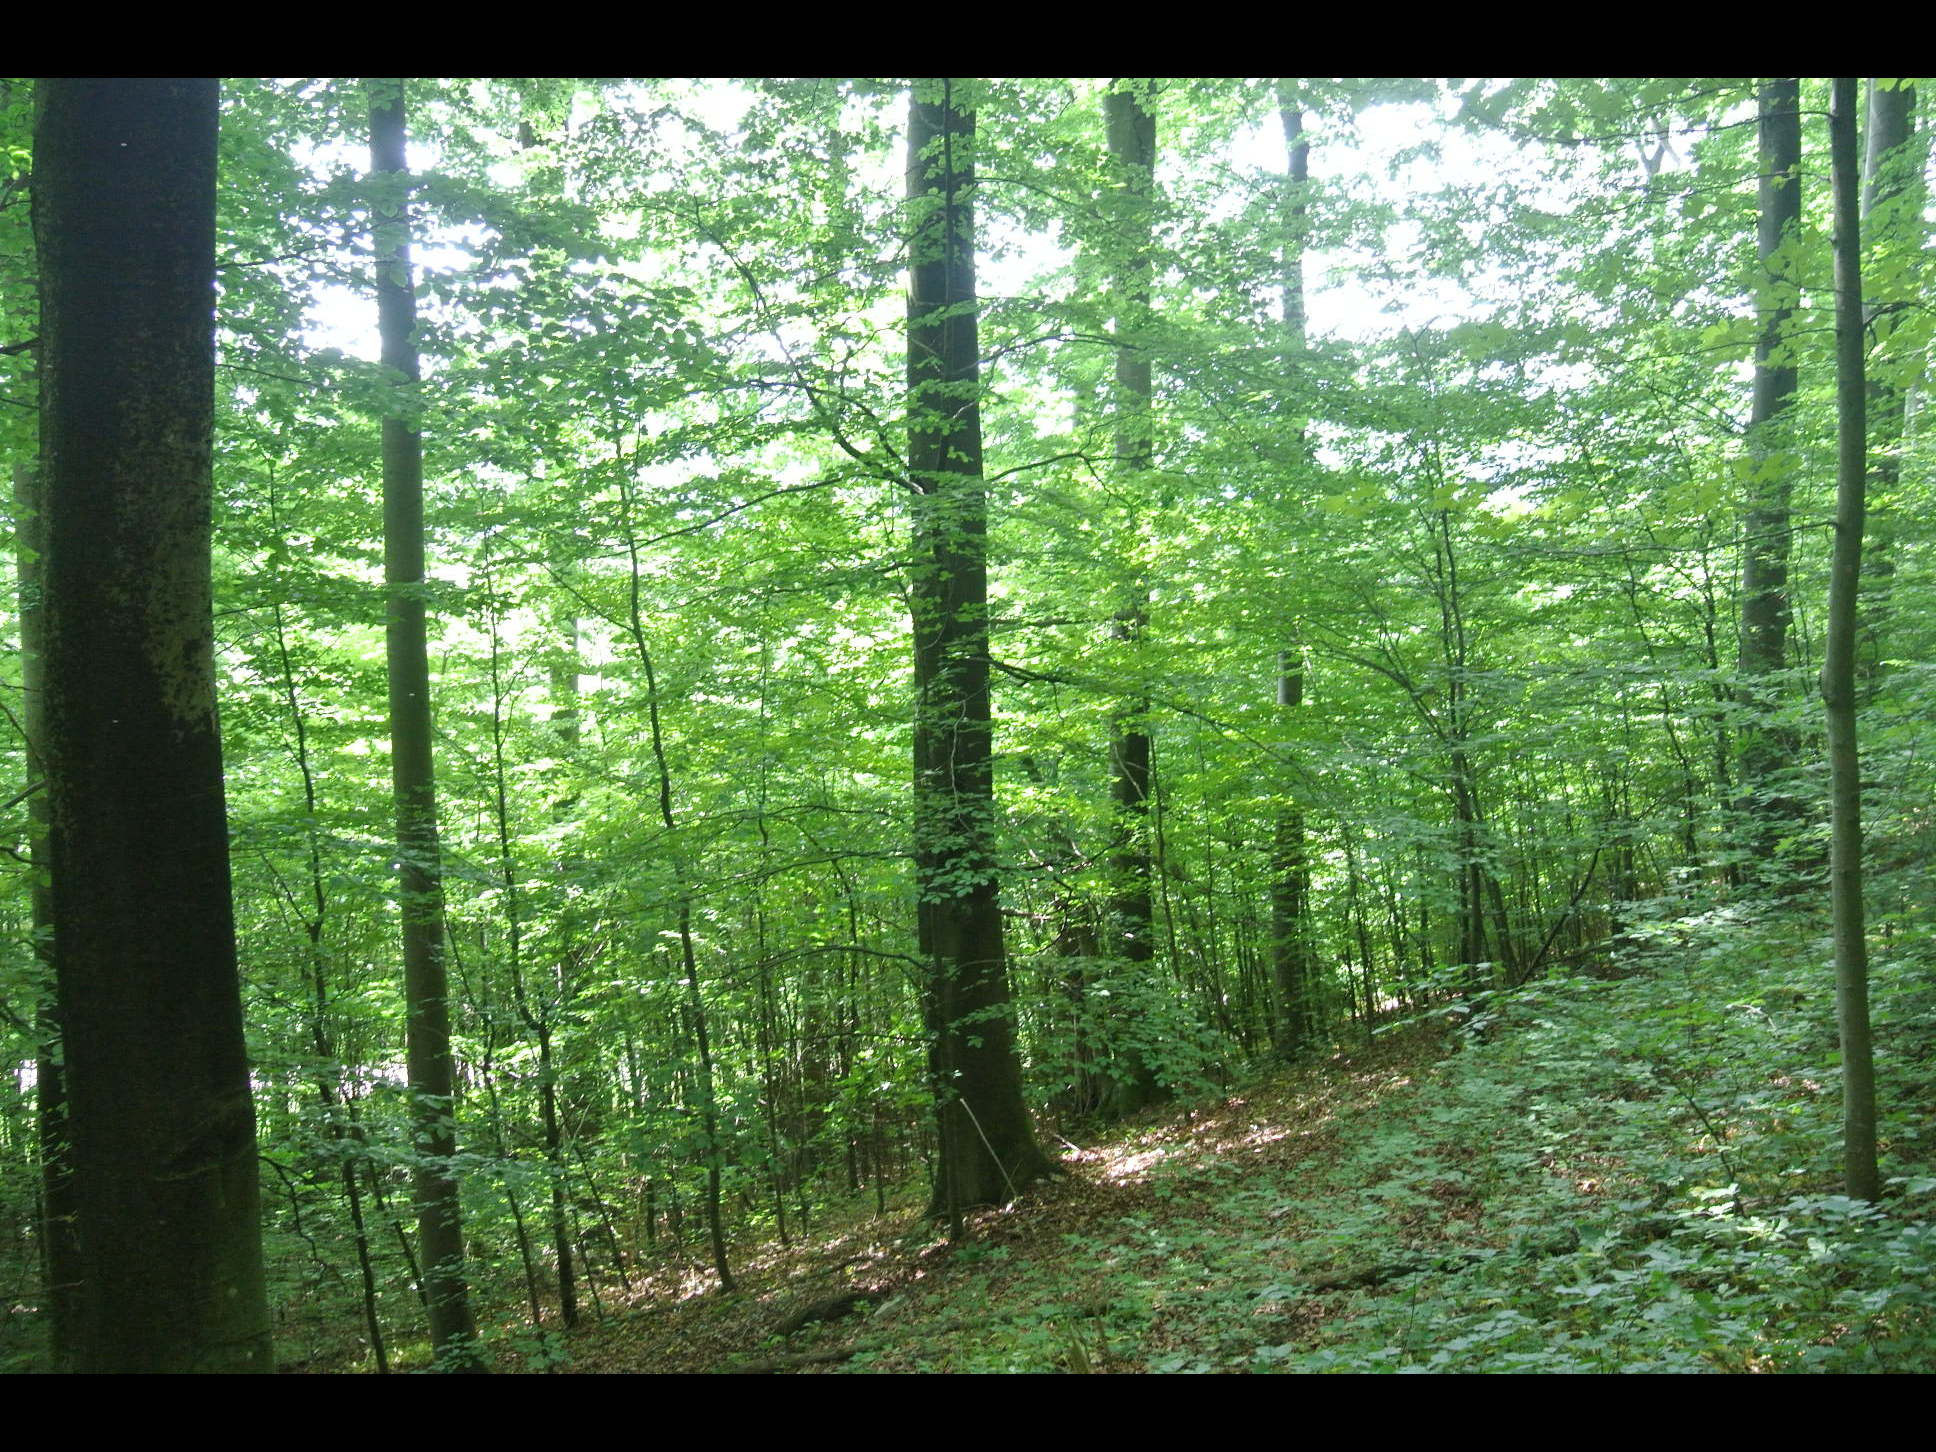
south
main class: Woodland
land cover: Broadleaved woodland
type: beech forest
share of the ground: > 75 %
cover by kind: broadleaved forest trees 100 %
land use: Forestry
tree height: > 5 m
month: June
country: AT
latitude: 48.0033
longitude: 16.0484
